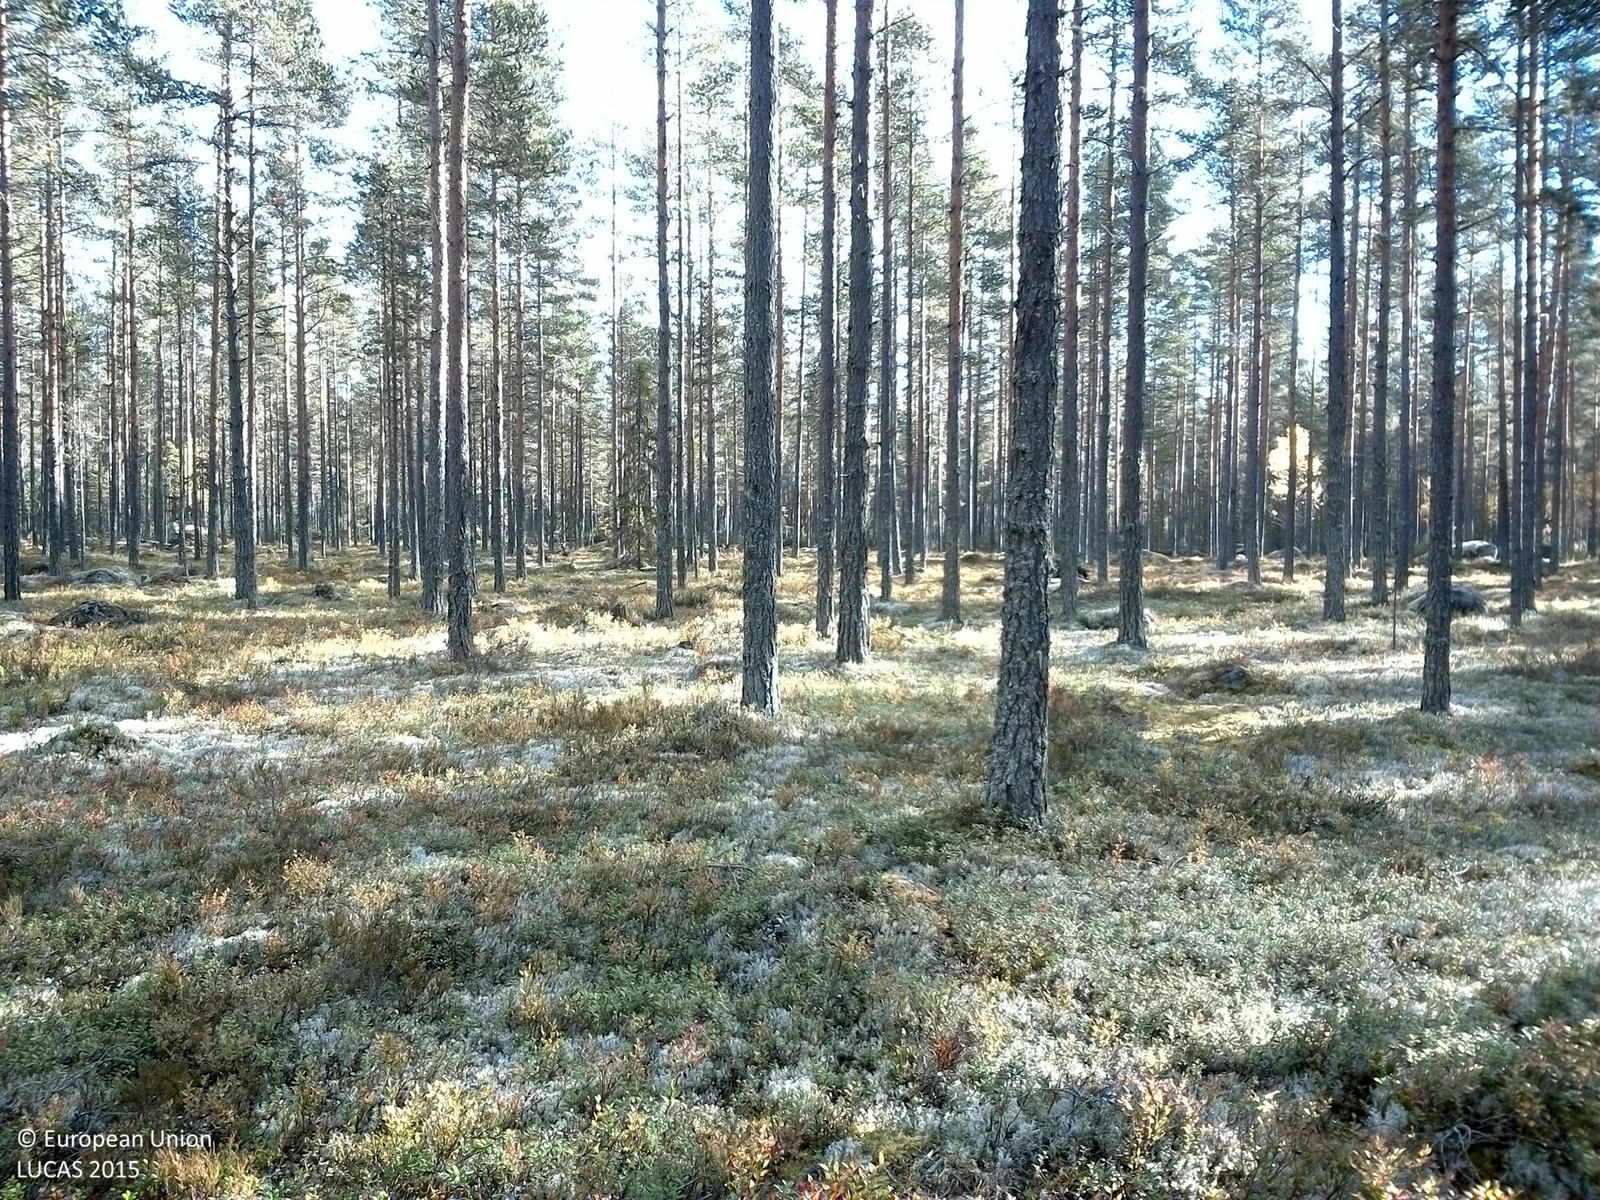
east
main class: Woodland
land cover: Pine dominated coniferous woodland
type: boreal forest
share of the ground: 50 - 75 %
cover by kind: coniferous forest trees 60 %, shrubs 30 %, lichens and mosses 5 %, consolidated bare surface 5 %
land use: Forestry
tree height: > 5 m
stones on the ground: 10 - 25 %
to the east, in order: Pine dominated coniferous woodland; Shrubland without tree cover; Ditches and canals; Paved roads, cycling and walking lanes; Ditches and canals; Shrubland without tree cover; Pine dominated coniferous woodland
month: October
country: SE
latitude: 61.2253
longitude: 15.1065
